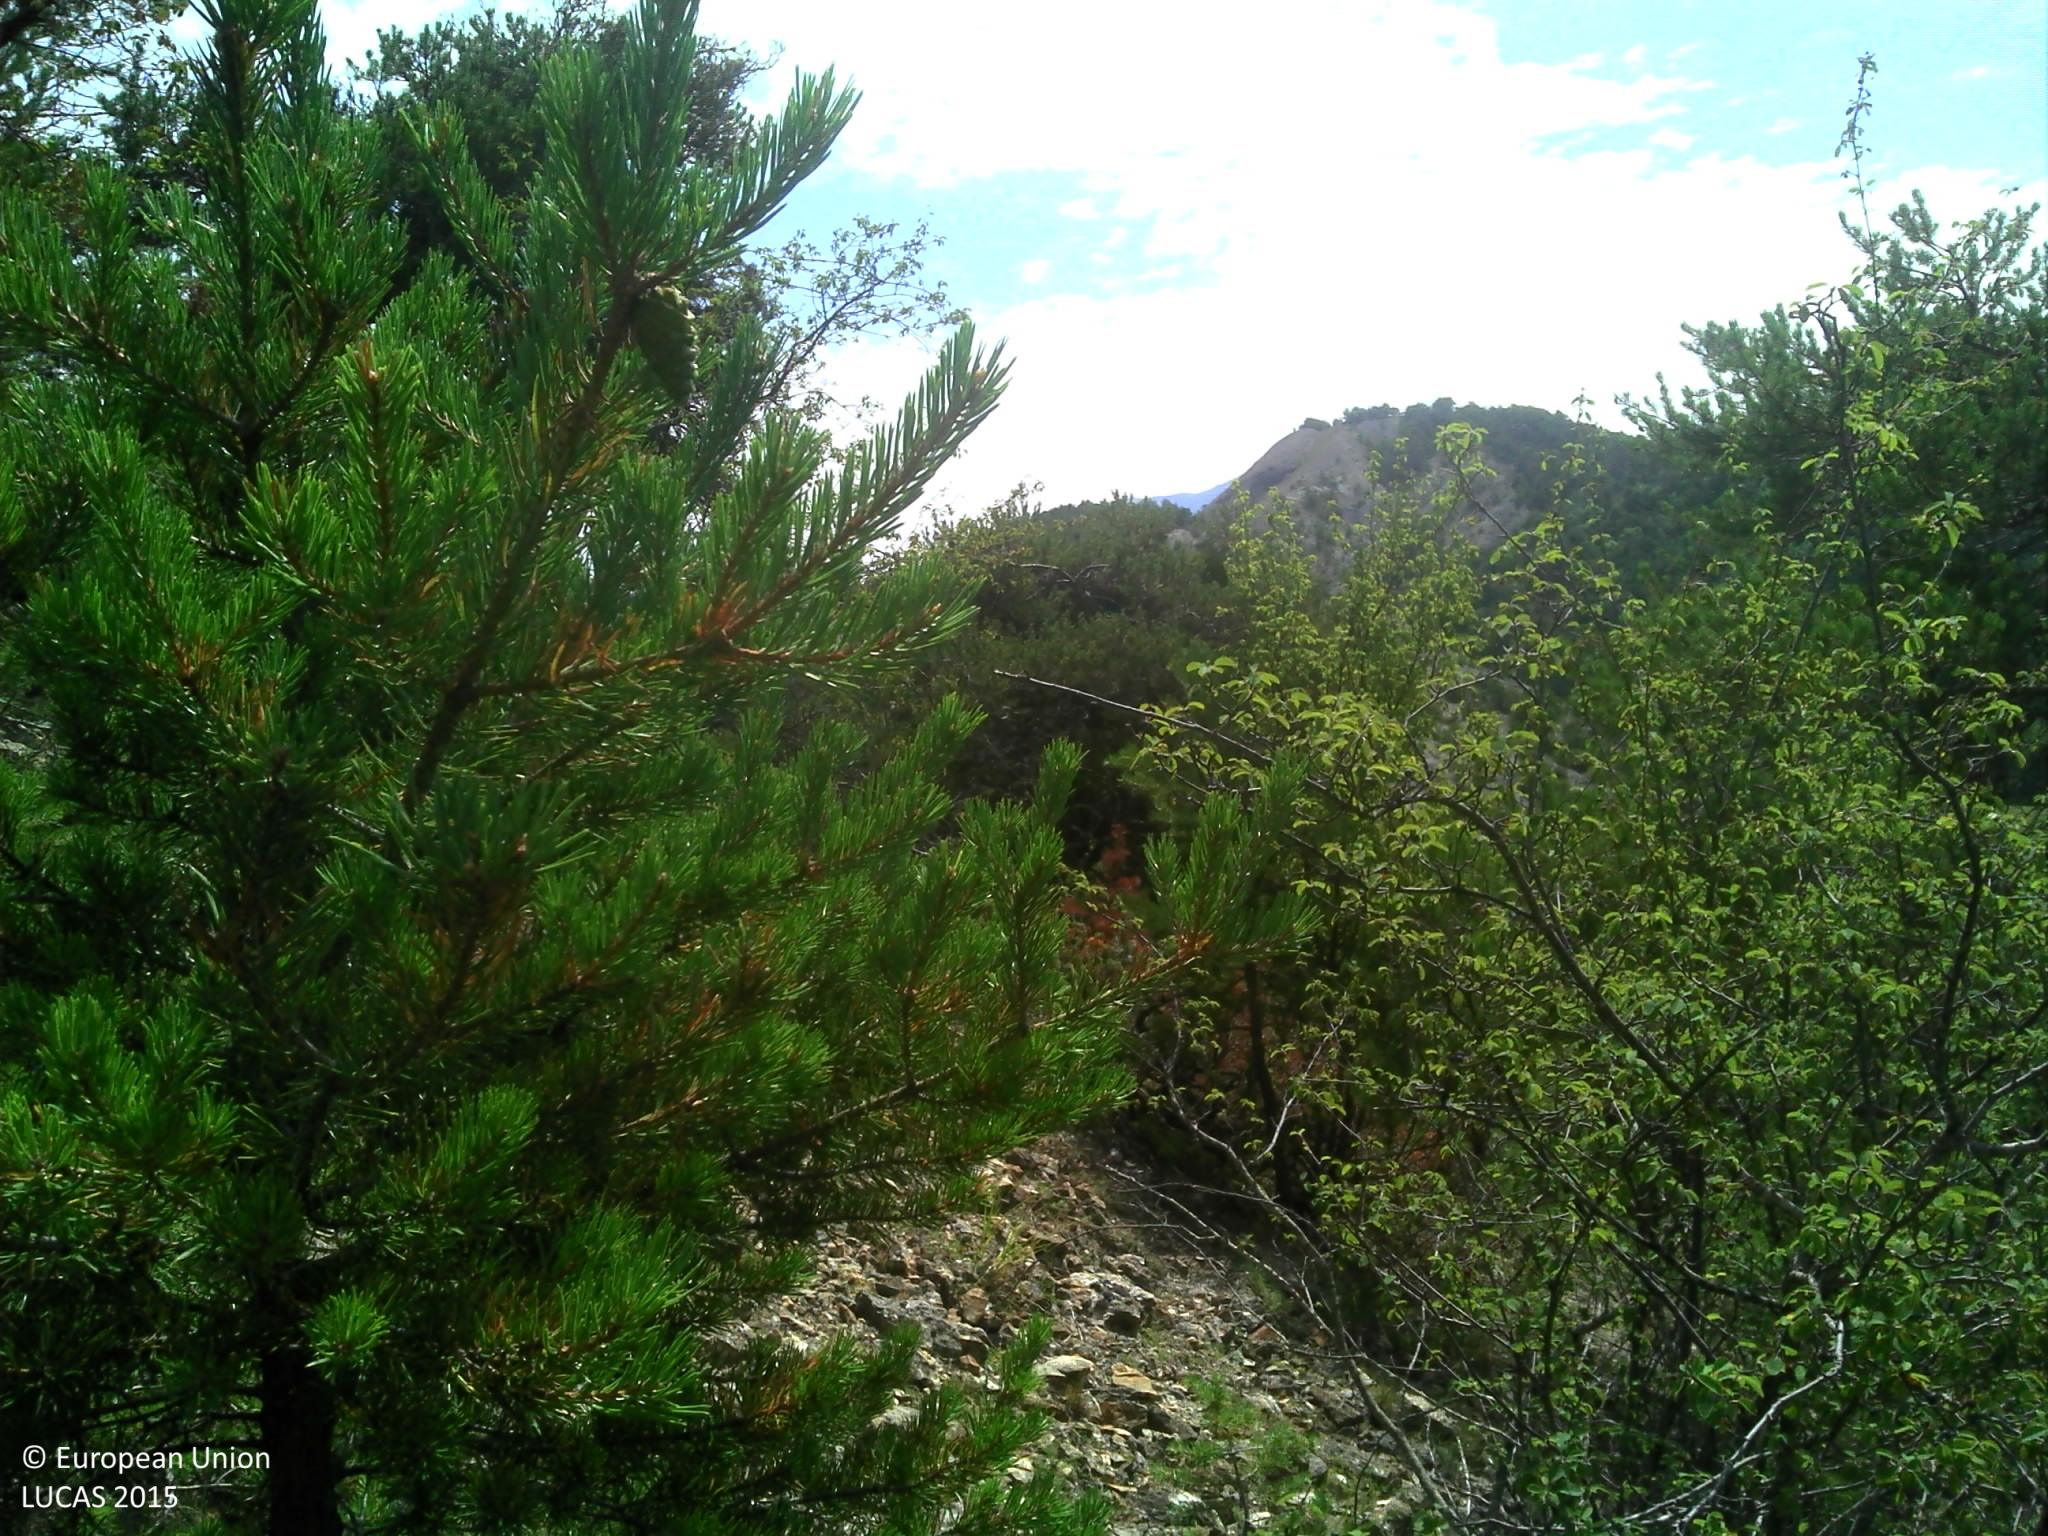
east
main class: Shrubland
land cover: Shrubland with sparse tree cover
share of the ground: 50 - 75 %
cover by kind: shrubs 50 %, unconsolidated bare surface 25 %, herbaceous plants 20 %, coniferous forest trees 5 %
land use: Semi-natural and natural areas not in use
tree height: < 5 m
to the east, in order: Shrubland with sparse tree cover; Pine dominated coniferous woodland; Tracks; Grass margins; Durum wheat; Pine dominated coniferous woodland; Rocks and stones; Shrubland without tree cover; Rocks and stones
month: July
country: FR
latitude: 44.4651
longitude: 6.2987
